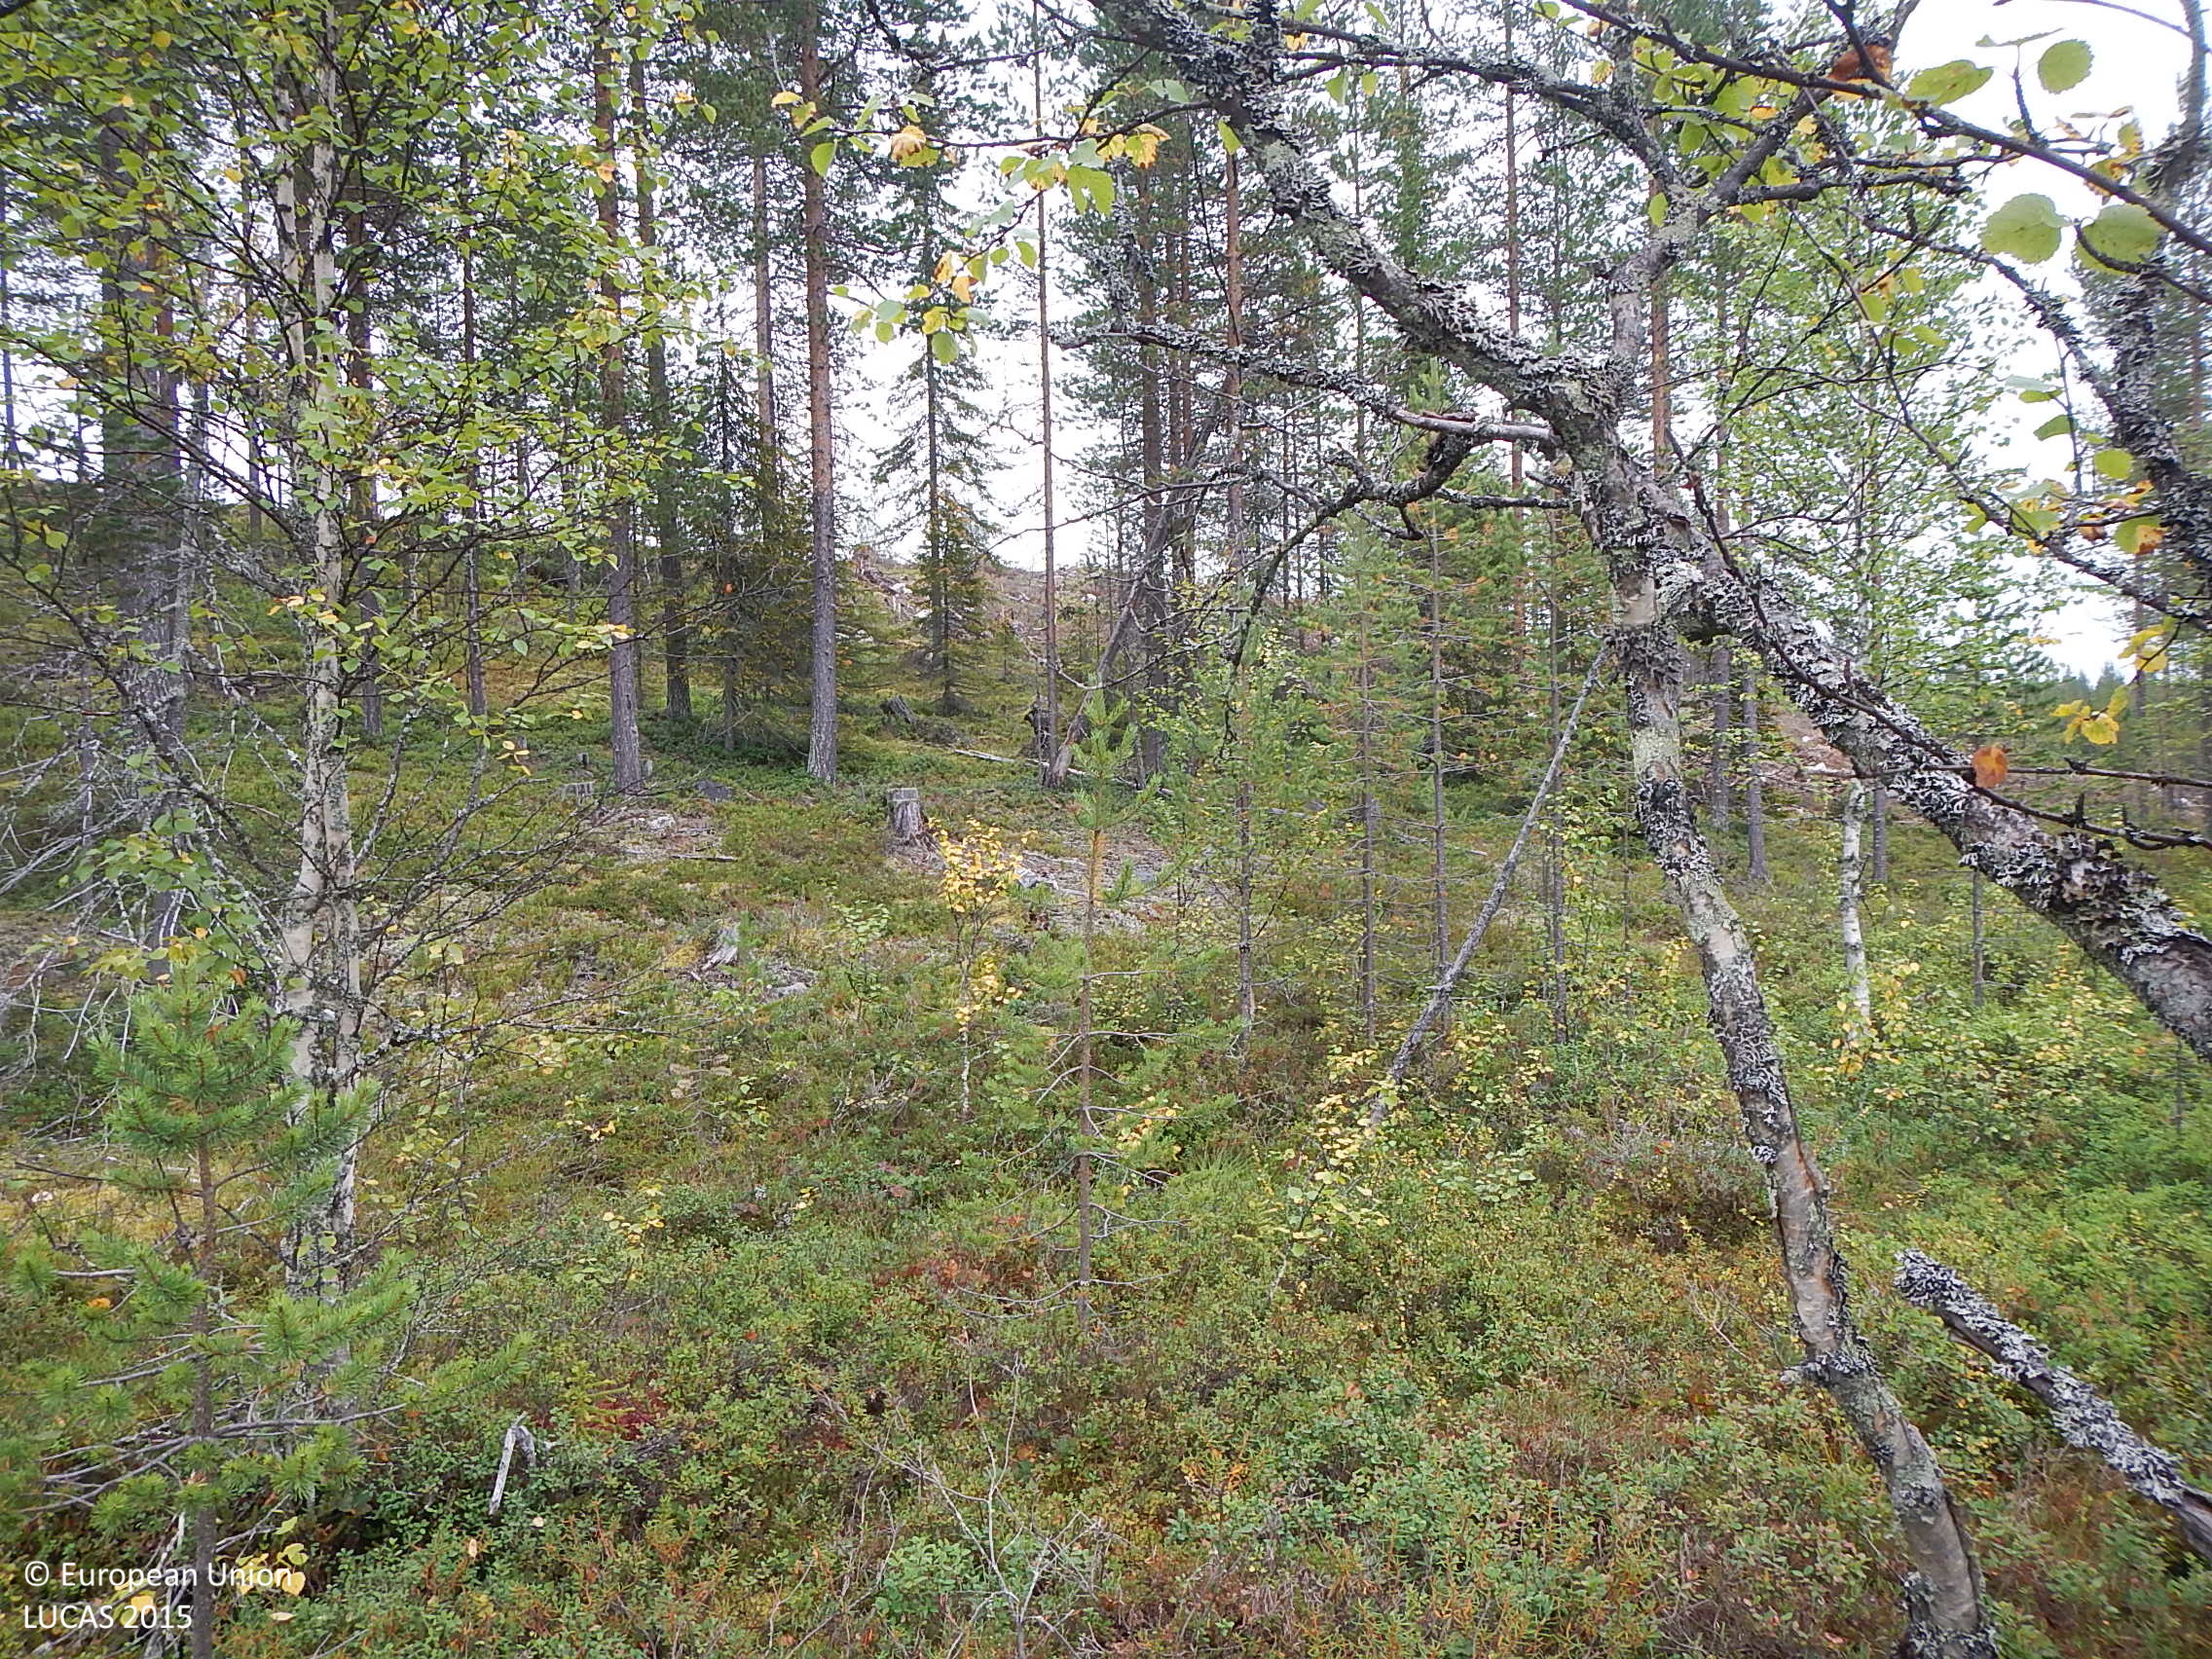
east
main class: Woodland
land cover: Pine dominated mixed woodland
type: boreal forest
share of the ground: 50 - 75 %
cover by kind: shrubs 40 %, coniferous forest trees 25 %, broadleaved forest trees 25 %, lichens and mosses 10 %
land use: Semi-natural and natural areas not in use
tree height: < 5 m
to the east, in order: Pine dominated mixed woodland; Pine dominated coniferous woodland; Shrubland without tree cover; Single bushes/trees; Shrubland without tree cover; Pine dominated coniferous woodland; Shrubland without tree cover
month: August
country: FI
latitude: 66.1547
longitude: 27.4761
